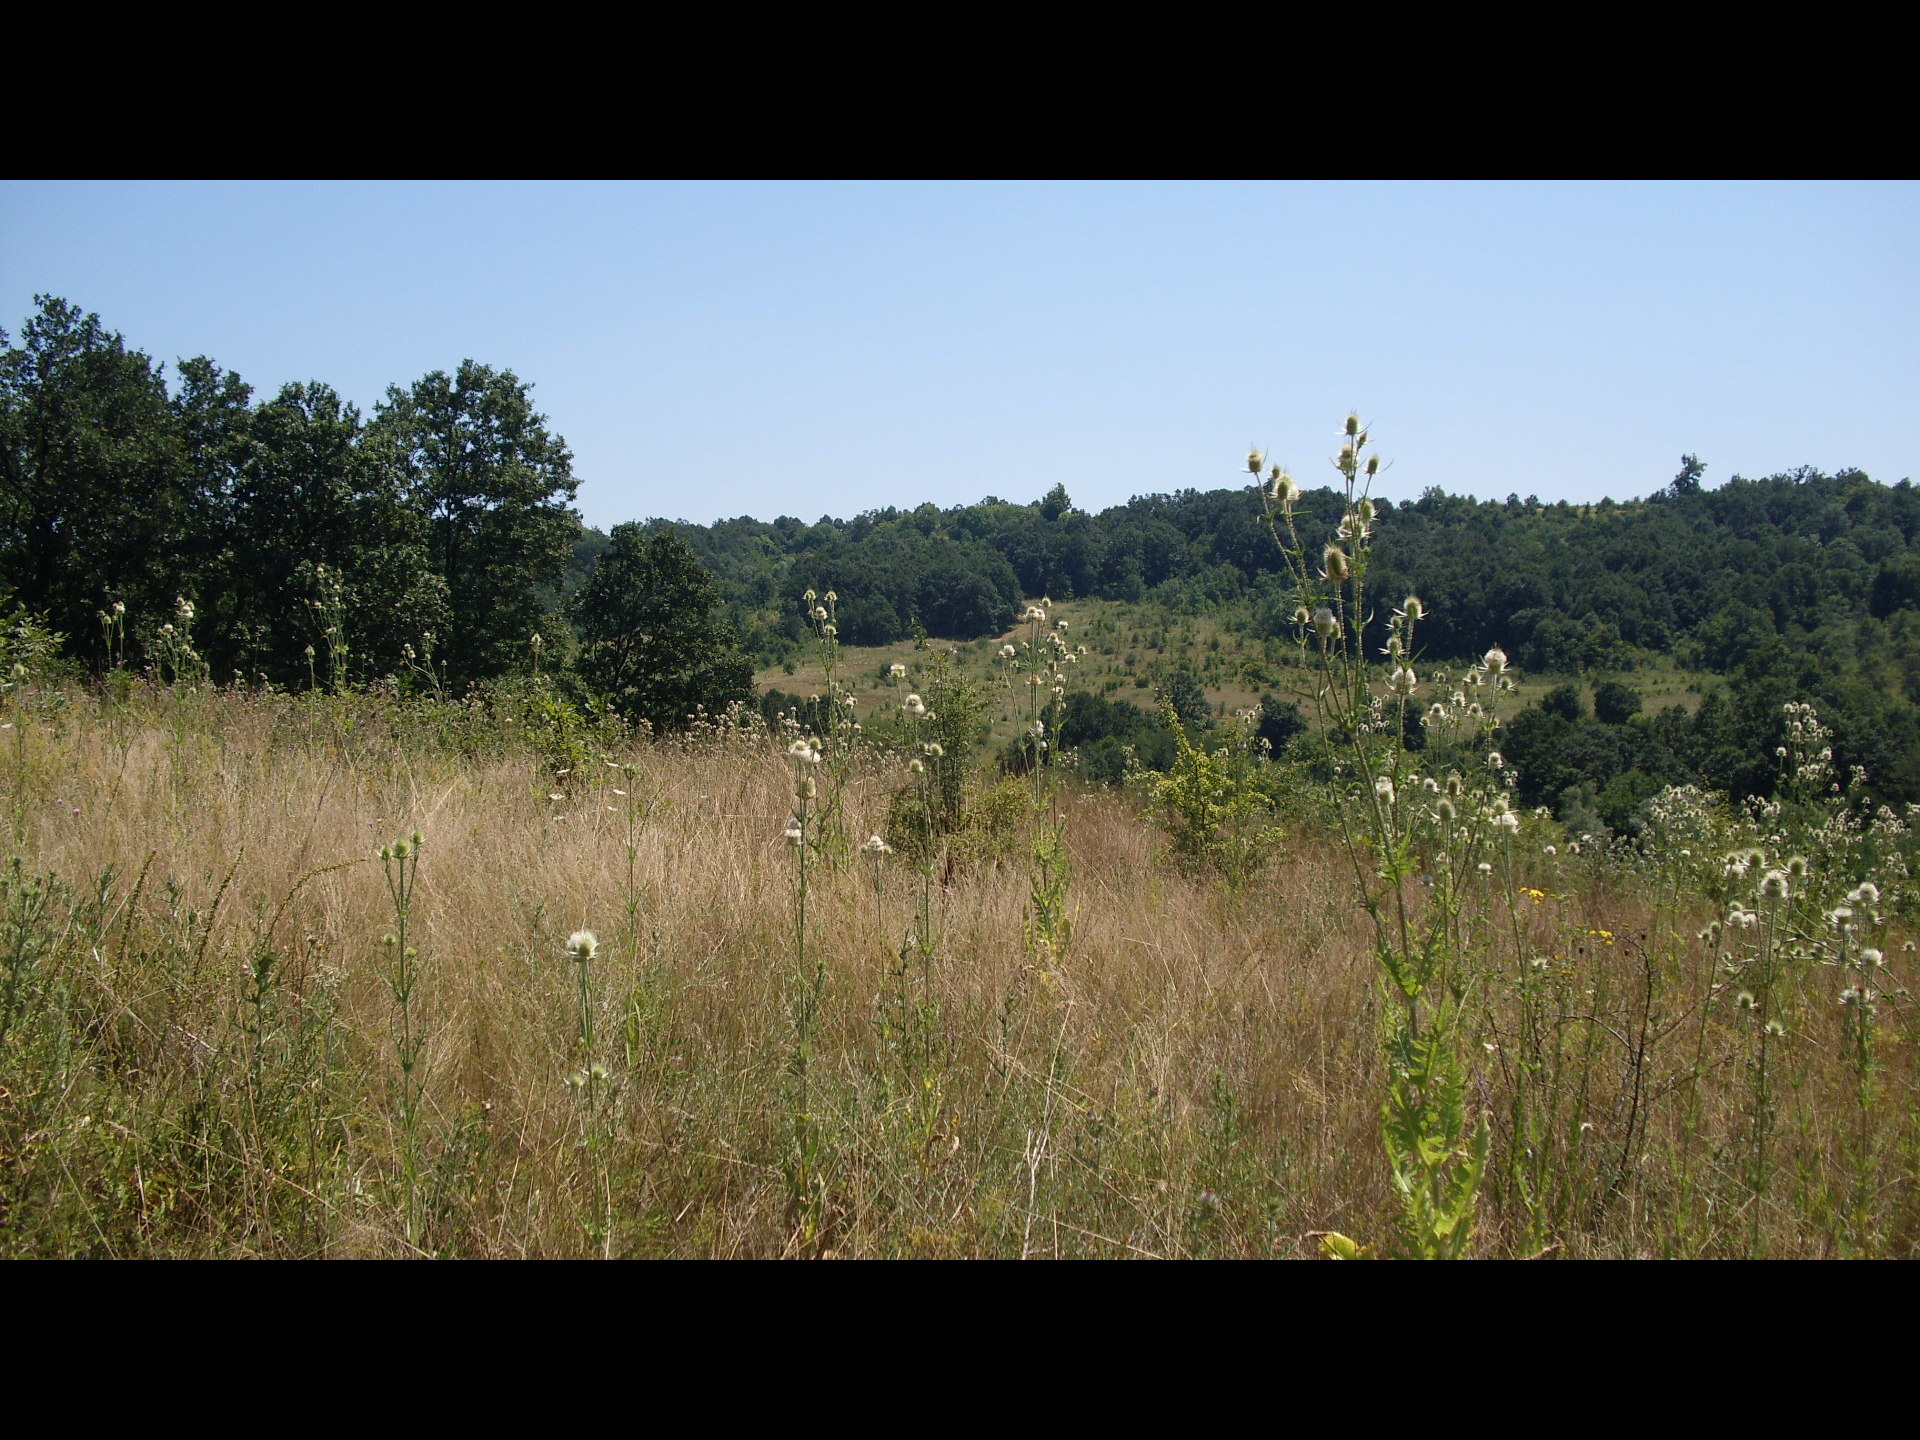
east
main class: Grassland
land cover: Grassland with sparse tree/shrub cover
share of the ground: > 75 %
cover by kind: herbaceous plants 85 %, shrubs 10 %, broadleaved forest trees 5 %
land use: Agriculture (excluding fallow land and kitchen gardens)
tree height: < 5 m
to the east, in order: Grassland with sparse tree/shrub cover; Tracks; Broadleaved woodland; Grassland with sparse tree/shrub cover; Tracks; Grassland with sparse tree/shrub cover
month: July
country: BG
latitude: 43.8218
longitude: 22.5545
